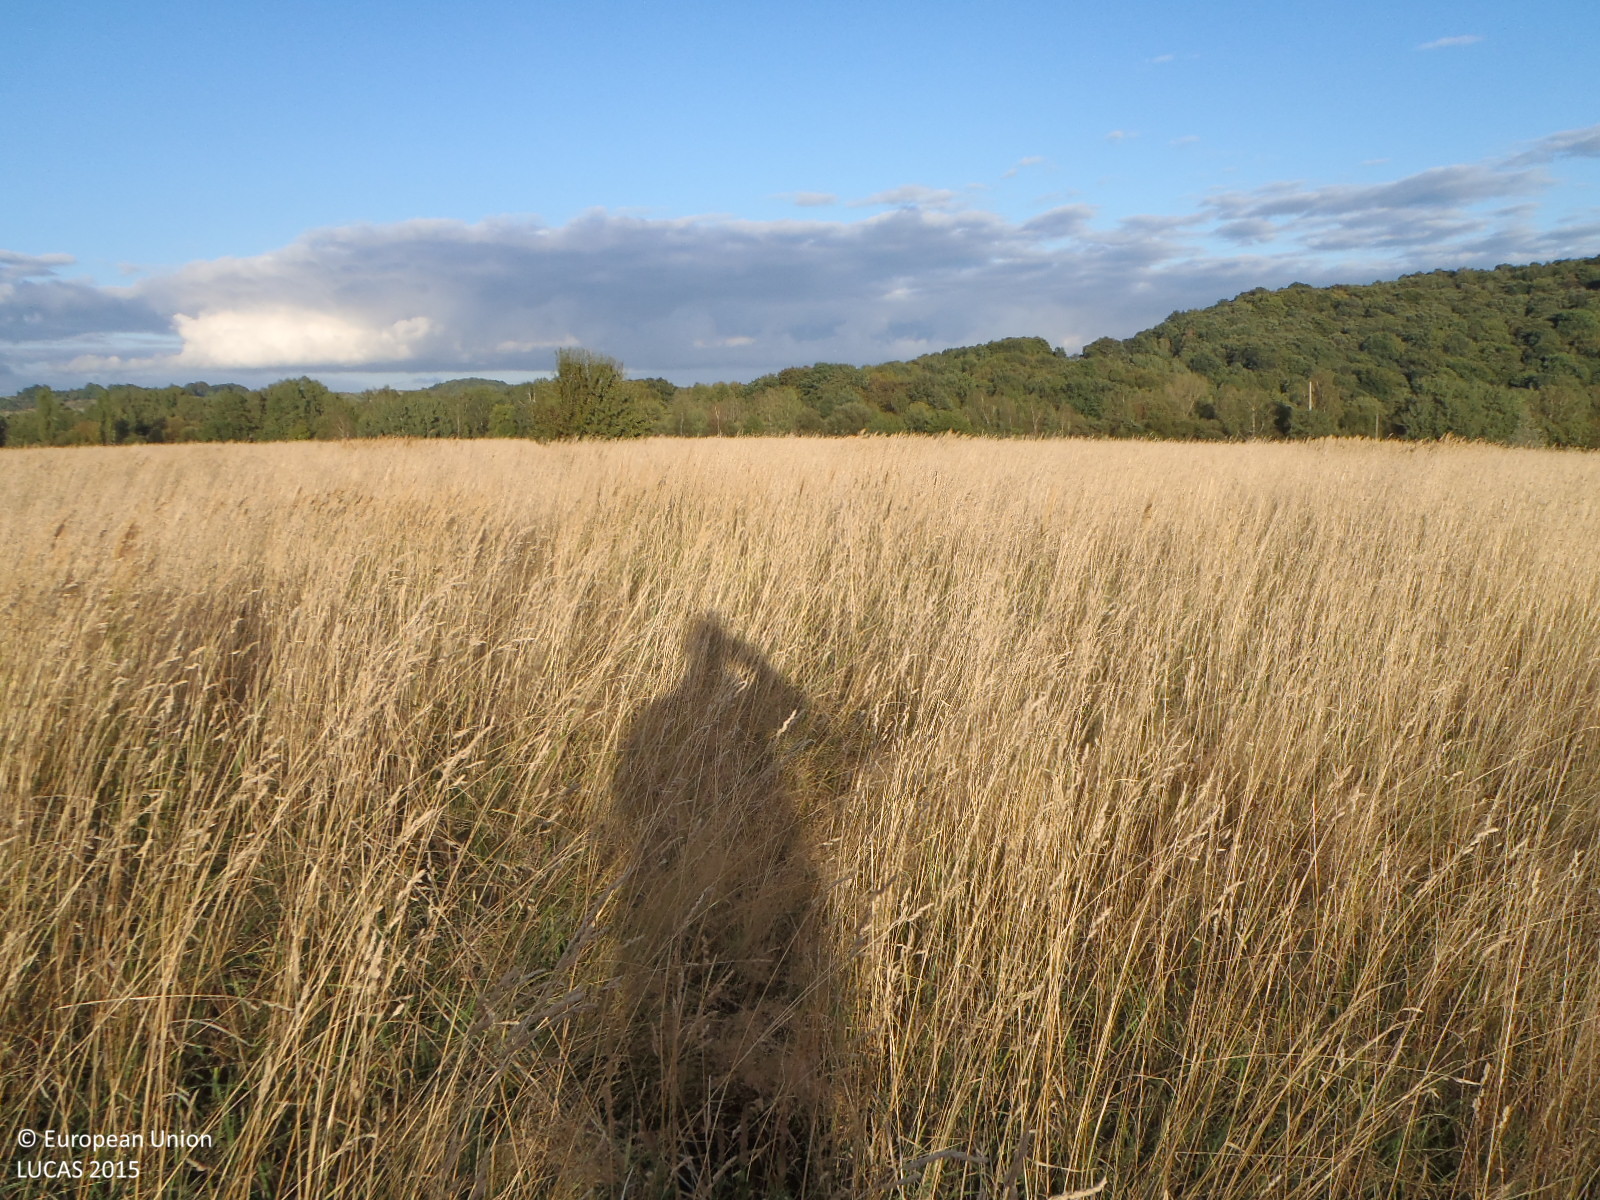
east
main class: Grassland
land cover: Grassland without tree/shrub cover
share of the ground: > 75 %
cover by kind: herbaceous plants 100 %
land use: Agriculture (excluding fallow land and kitchen gardens)
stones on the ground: < 10 %
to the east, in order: Grassland without tree/shrub cover; Ditches and canals; Grass margins; Paved roads, cycling and walking lanes; Grass margins; Abandoned hedges; Grassland without tree/shrub cover
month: September
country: CZ
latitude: 50.7259
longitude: 14.0101
